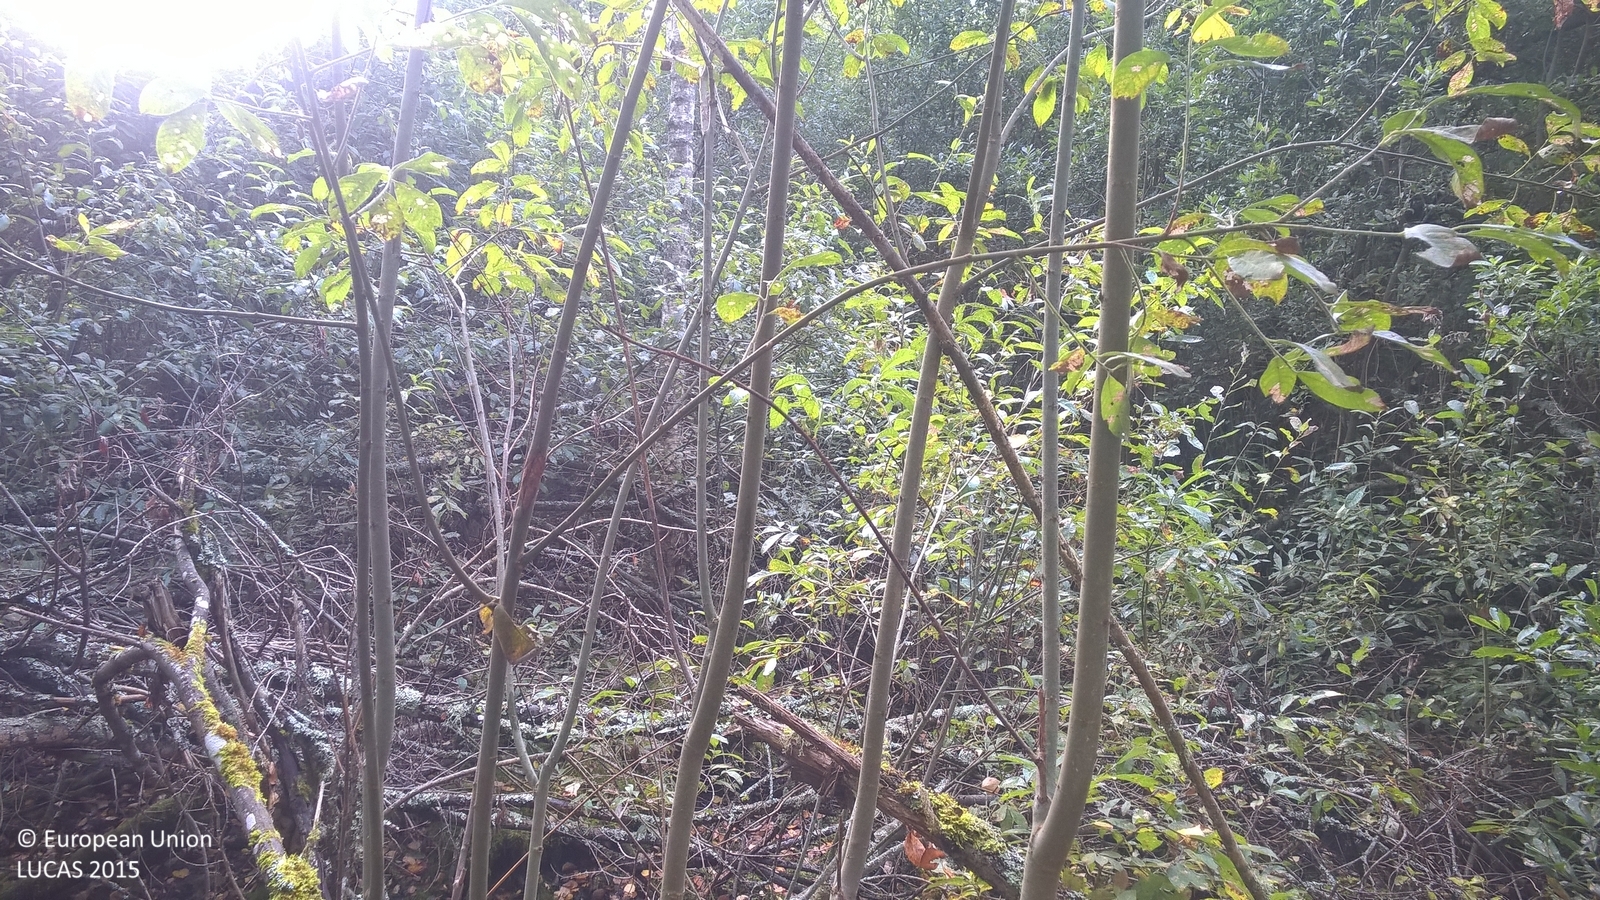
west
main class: Woodland
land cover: Broadleaved woodland
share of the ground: > 75 %
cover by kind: broadleaved forest trees 80 %, lichens and mosses 10 %, coniferous forest trees 5 %, herbaceous plants 5 %
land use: Semi-natural and natural areas not in use
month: September
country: LV
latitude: 57.7968
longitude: 25.7493
